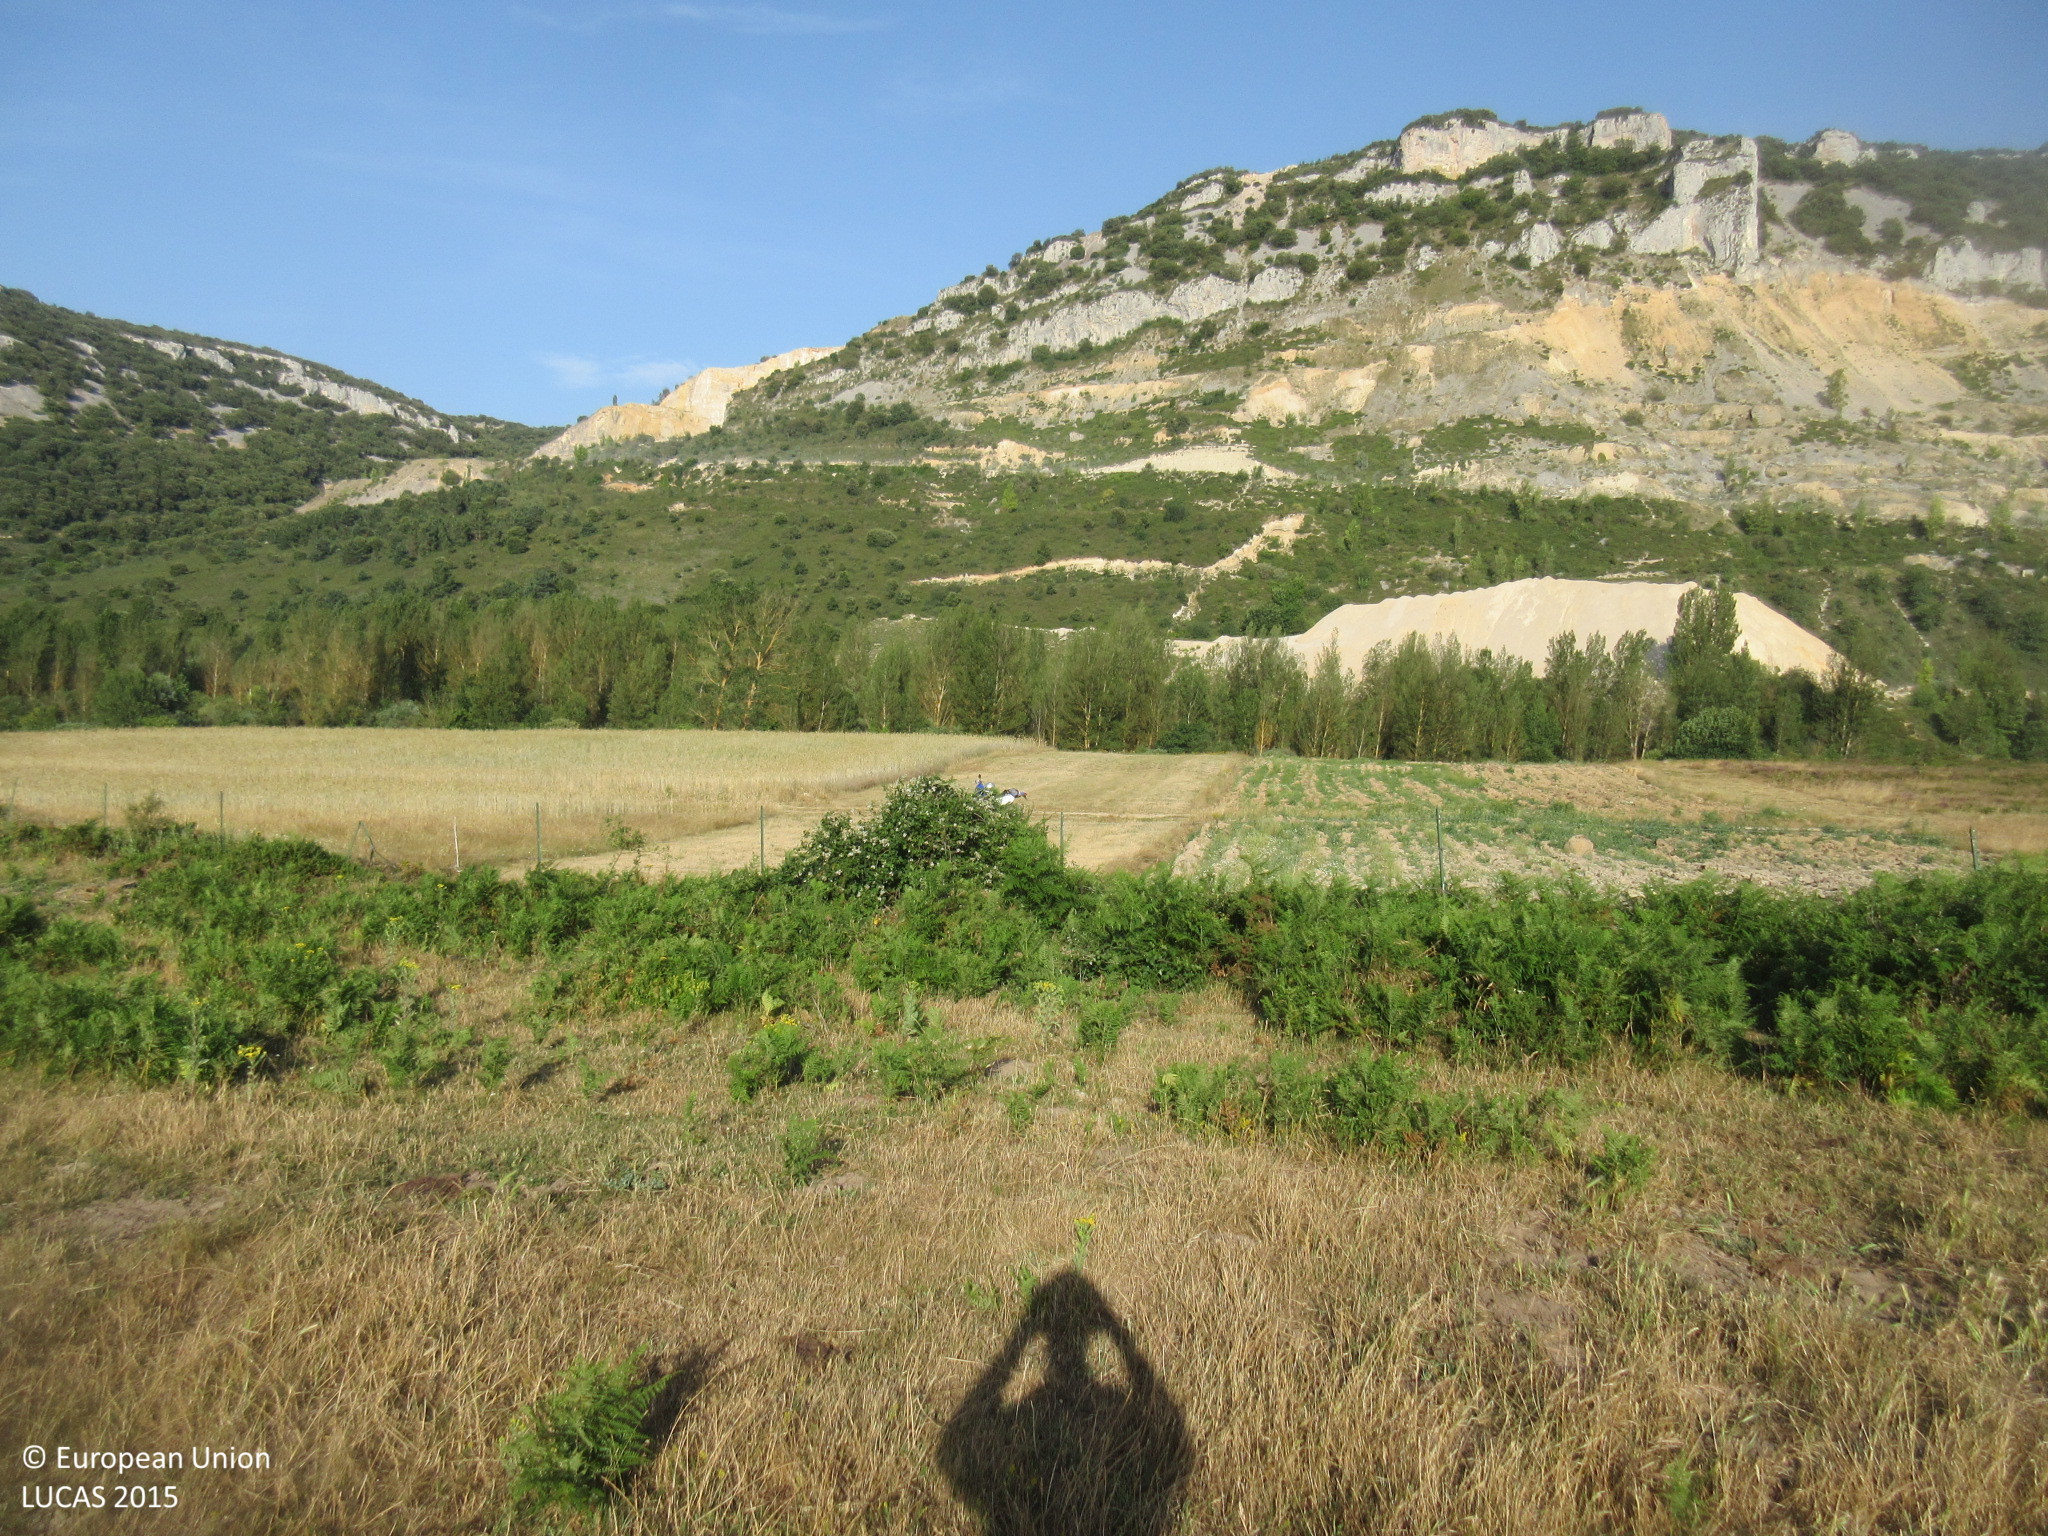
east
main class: Grassland
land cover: Grassland without tree/shrub cover
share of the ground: > 75 %
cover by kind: herbaceous plants 100 %
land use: Agriculture (excluding fallow land and kitchen gardens)
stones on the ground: < 10 %
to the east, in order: Grassland without tree/shrub cover; Fences; Rye; Tracks; Rye; Shrubland with sparse tree cover; Rye; Spontaneously vegetated surfaces
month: July
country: ES
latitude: 43.0459
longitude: -3.4821
